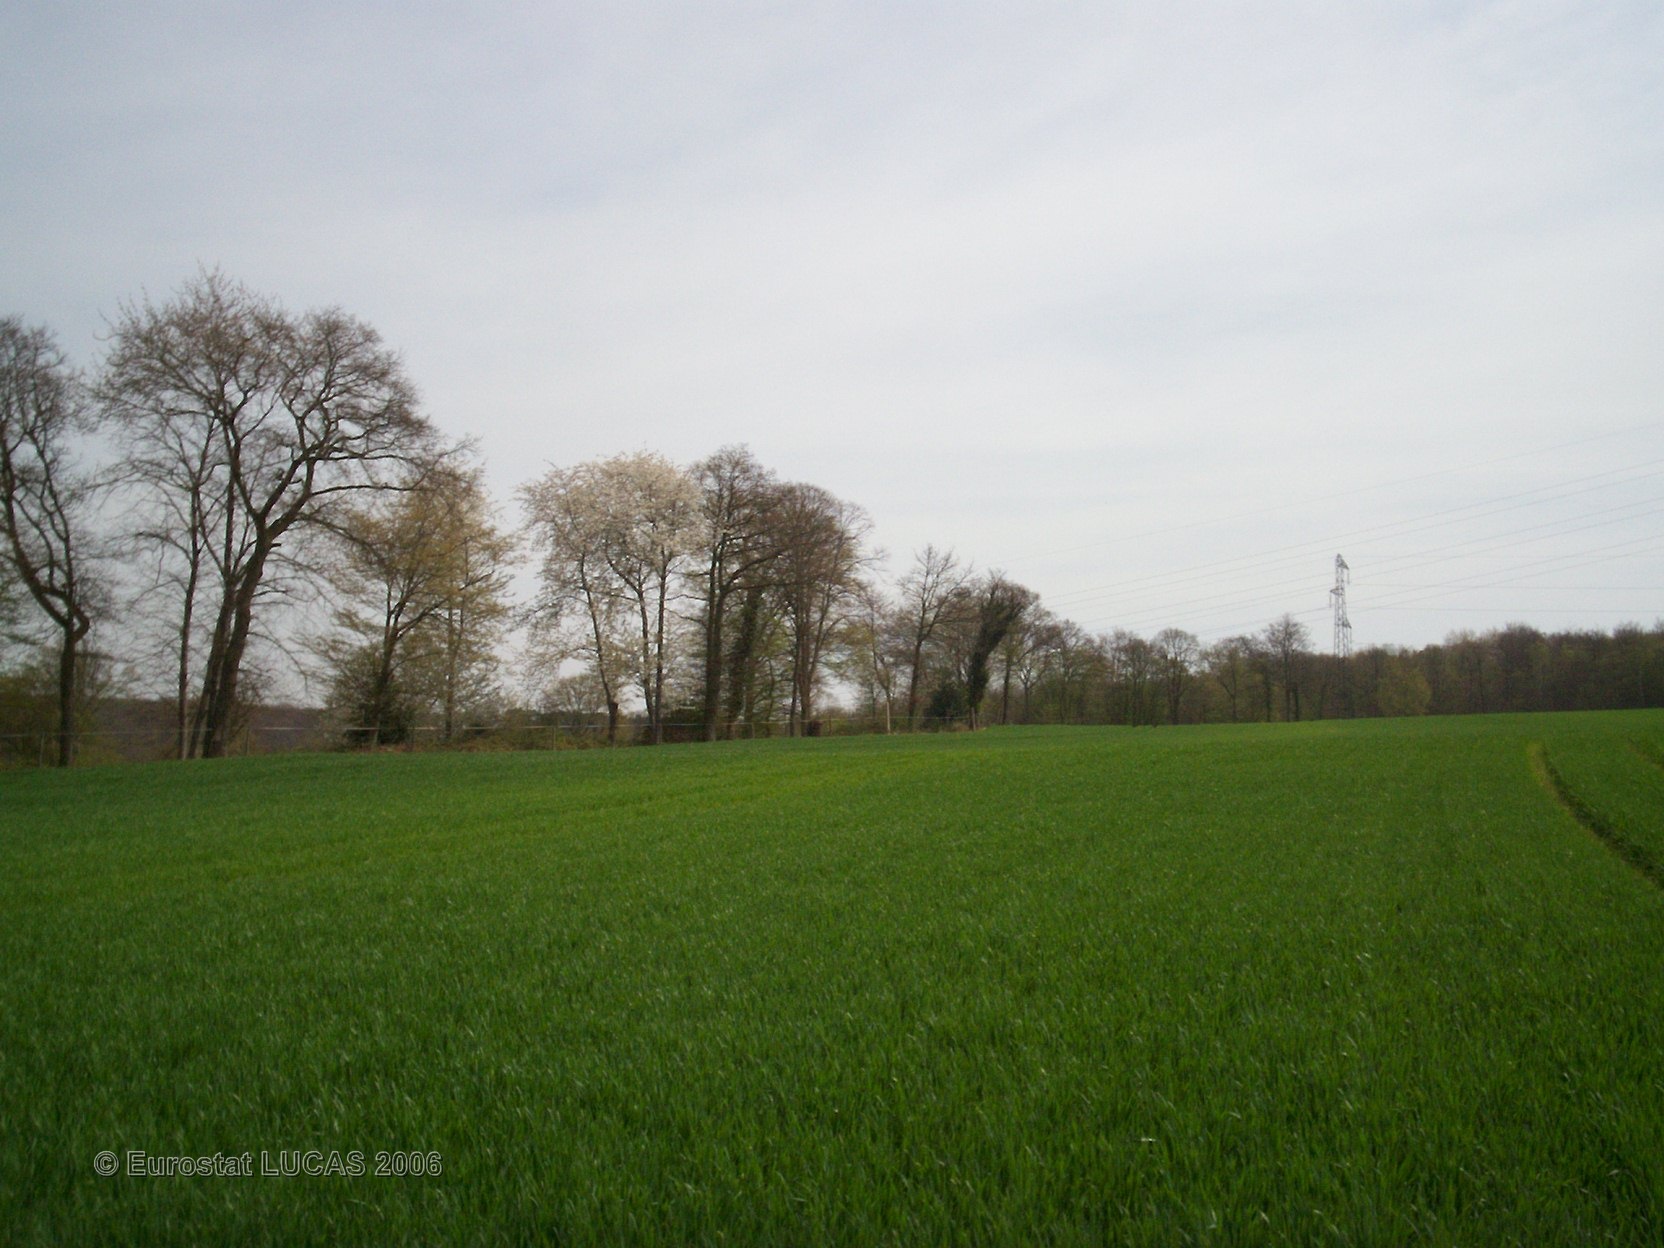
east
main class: Cropland
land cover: Common wheat
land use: Agriculture (excluding fallow land and kitchen gardens)
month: April
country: FR
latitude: 49.4075
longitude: 0.9502
